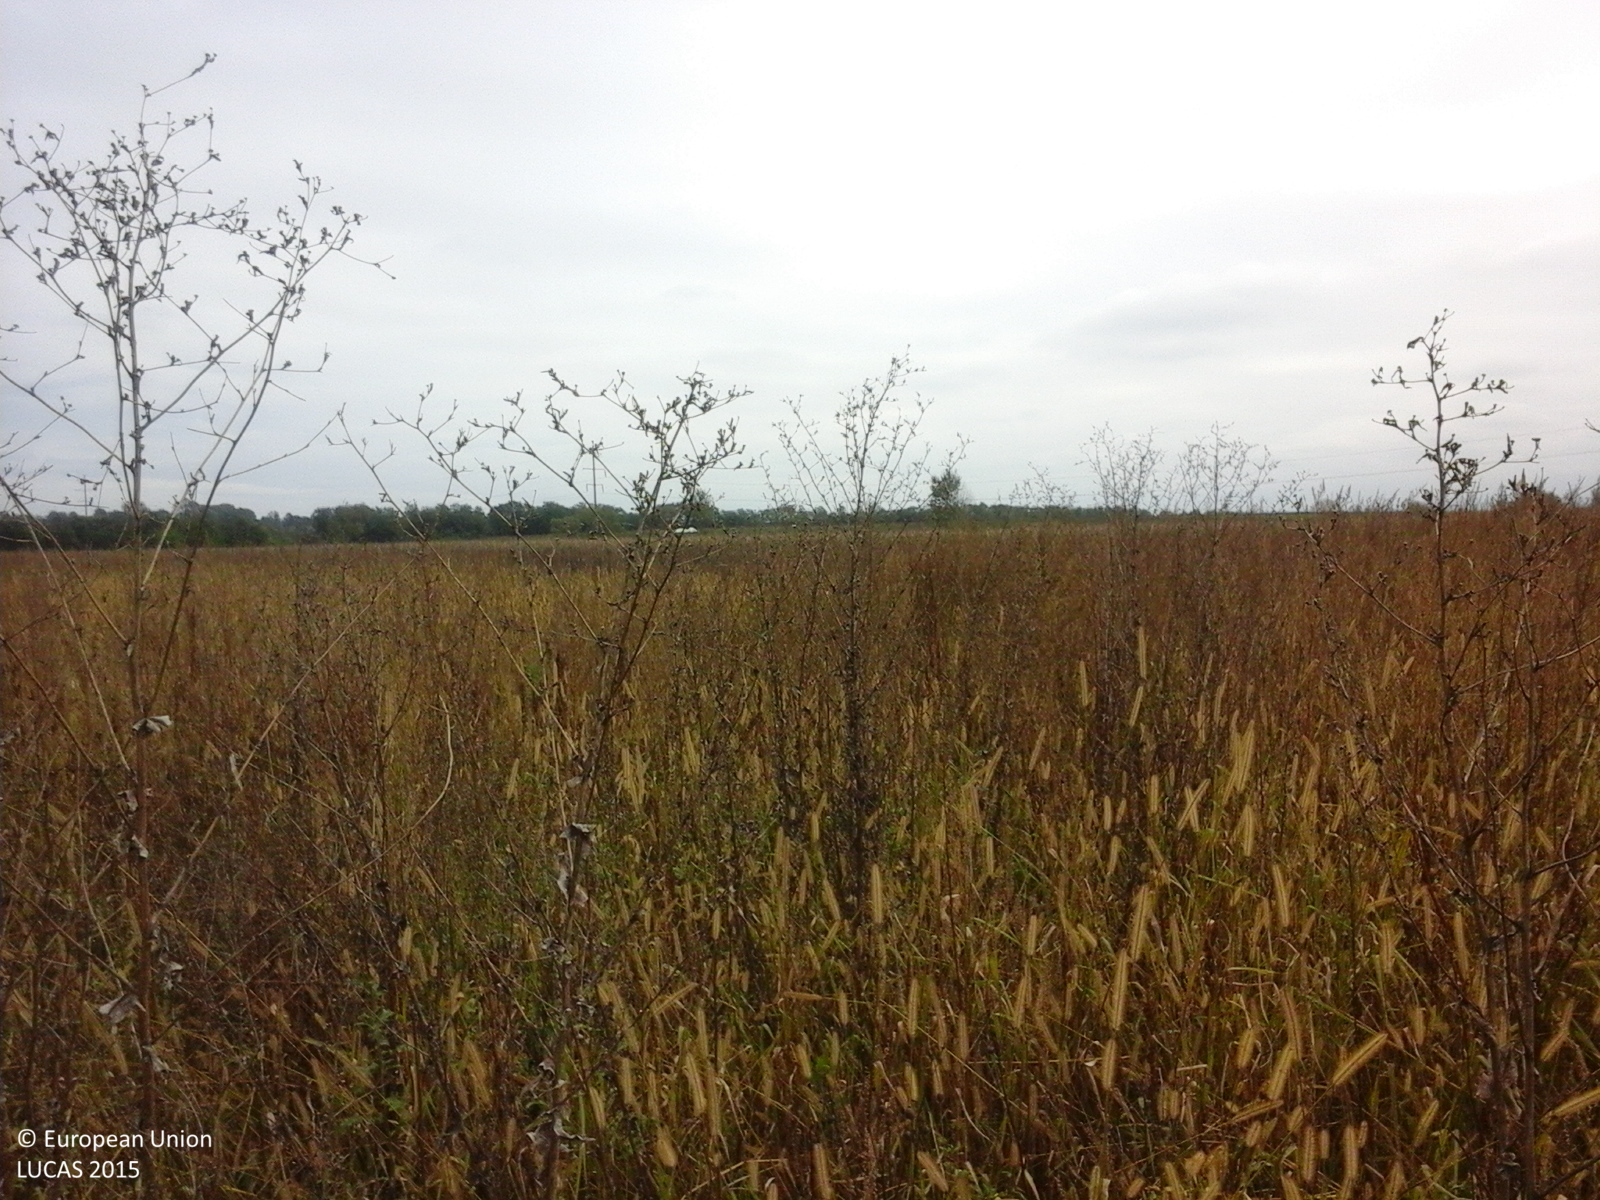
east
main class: Grassland
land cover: Spontaneously vegetated surfaces
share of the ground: > 75 %
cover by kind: herbaceous plants 100 %
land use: Agriculture (excluding fallow land and kitchen gardens)
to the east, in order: Spontaneously vegetated surfaces; Other bare soil; Maize
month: October
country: RO
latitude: 45.8265
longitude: 24.9326
